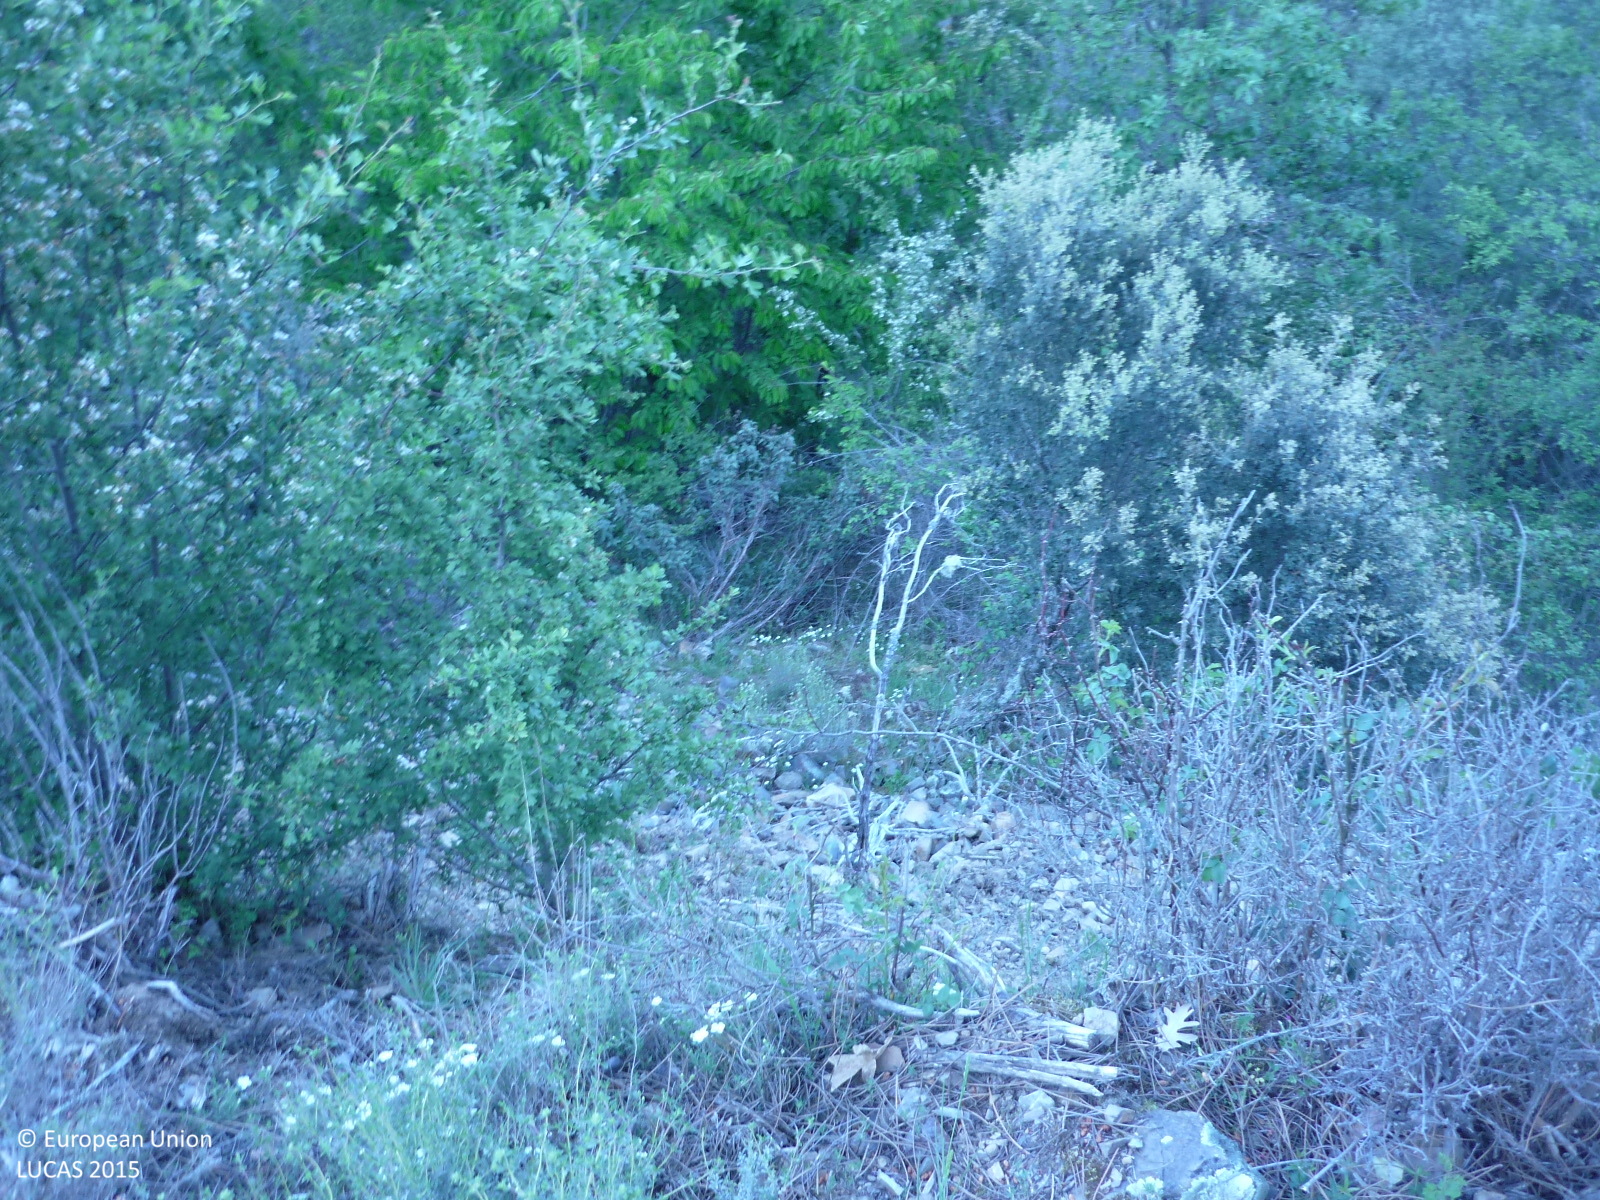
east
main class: Woodland
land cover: Broadleaved woodland
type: thermophilous deciduous forest
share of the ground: > 75 %
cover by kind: broadleaved forest trees 80 %, shrubs 10 %, herbaceous plants 10 %
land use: Semi-natural and natural areas not in use
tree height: < 5 m
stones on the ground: < 10 %
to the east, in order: Broadleaved woodland; Pine dominated coniferous woodland; Tracks; Pine dominated coniferous woodland; Tracks
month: May
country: ES
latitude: 41.0311
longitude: -3.3741
